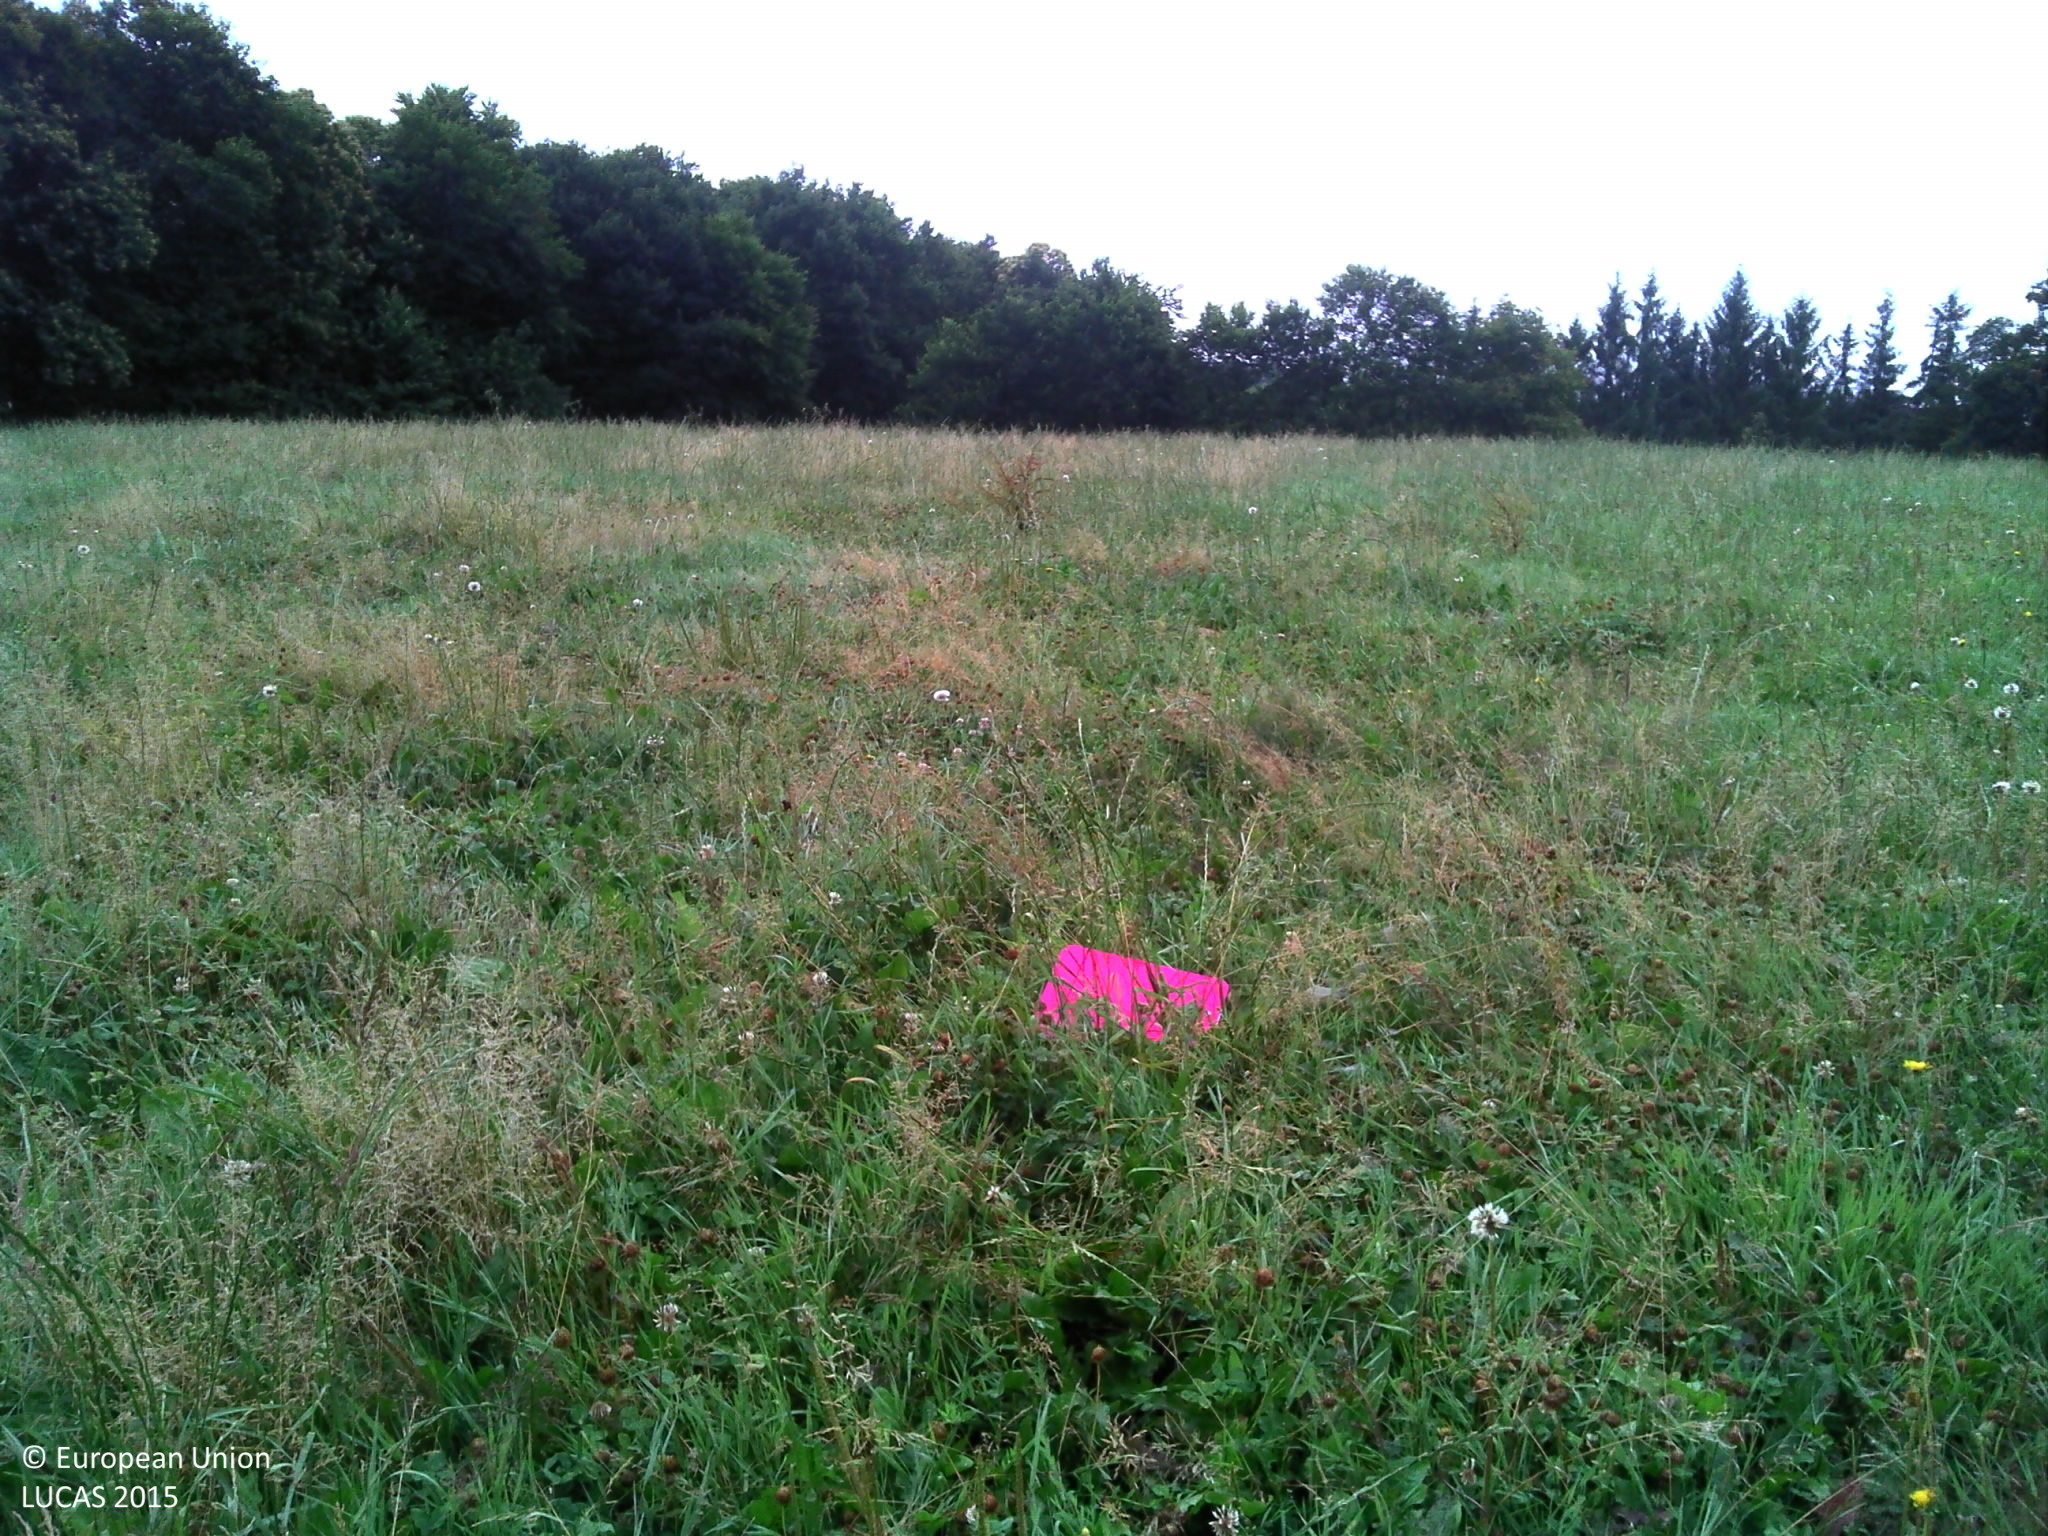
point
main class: Grassland
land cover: Grassland without tree/shrub cover
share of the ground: > 75 %
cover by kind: herbaceous plants 100 %
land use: Agriculture (excluding fallow land and kitchen gardens)
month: July
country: FR
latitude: 48.2555
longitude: -1.6723
